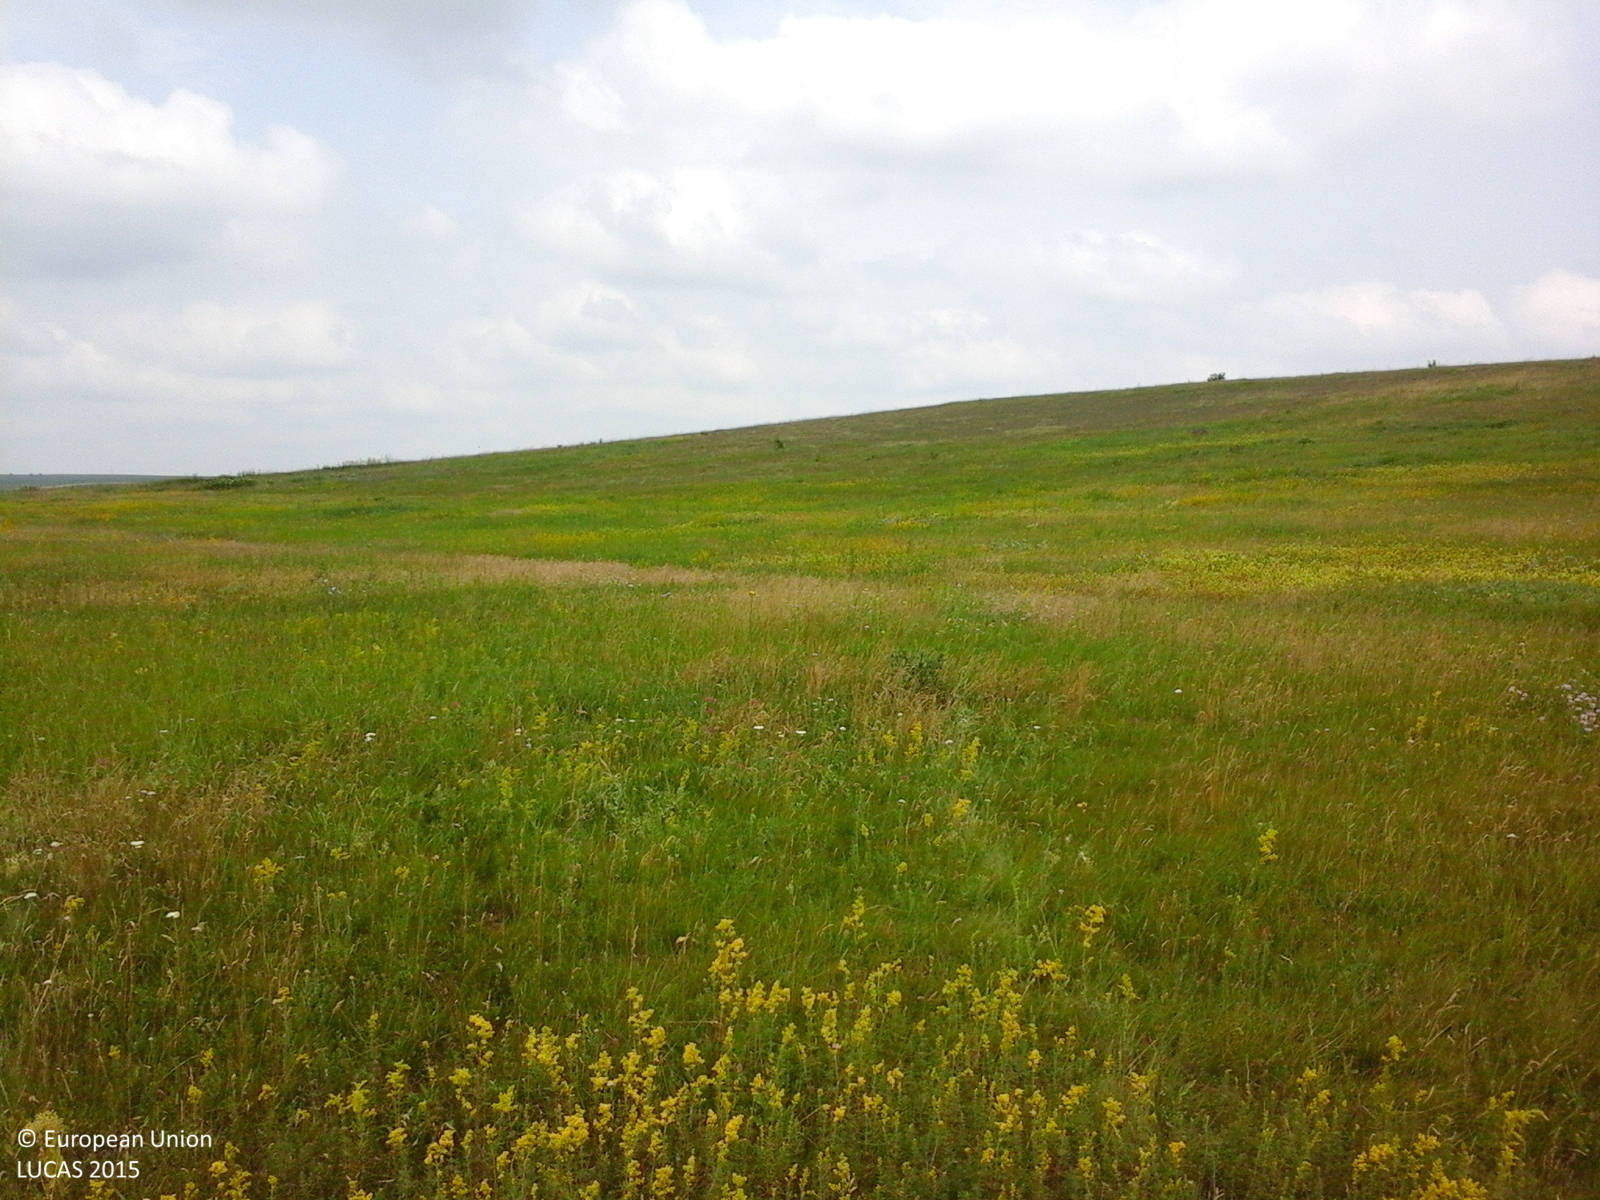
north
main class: Grassland
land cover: Grassland without tree/shrub cover
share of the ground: > 75 %
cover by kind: herbaceous plants 100 %
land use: Agriculture (excluding fallow land and kitchen gardens)
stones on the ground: < 10 %
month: June
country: RO
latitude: 48.0362
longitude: 26.6053
